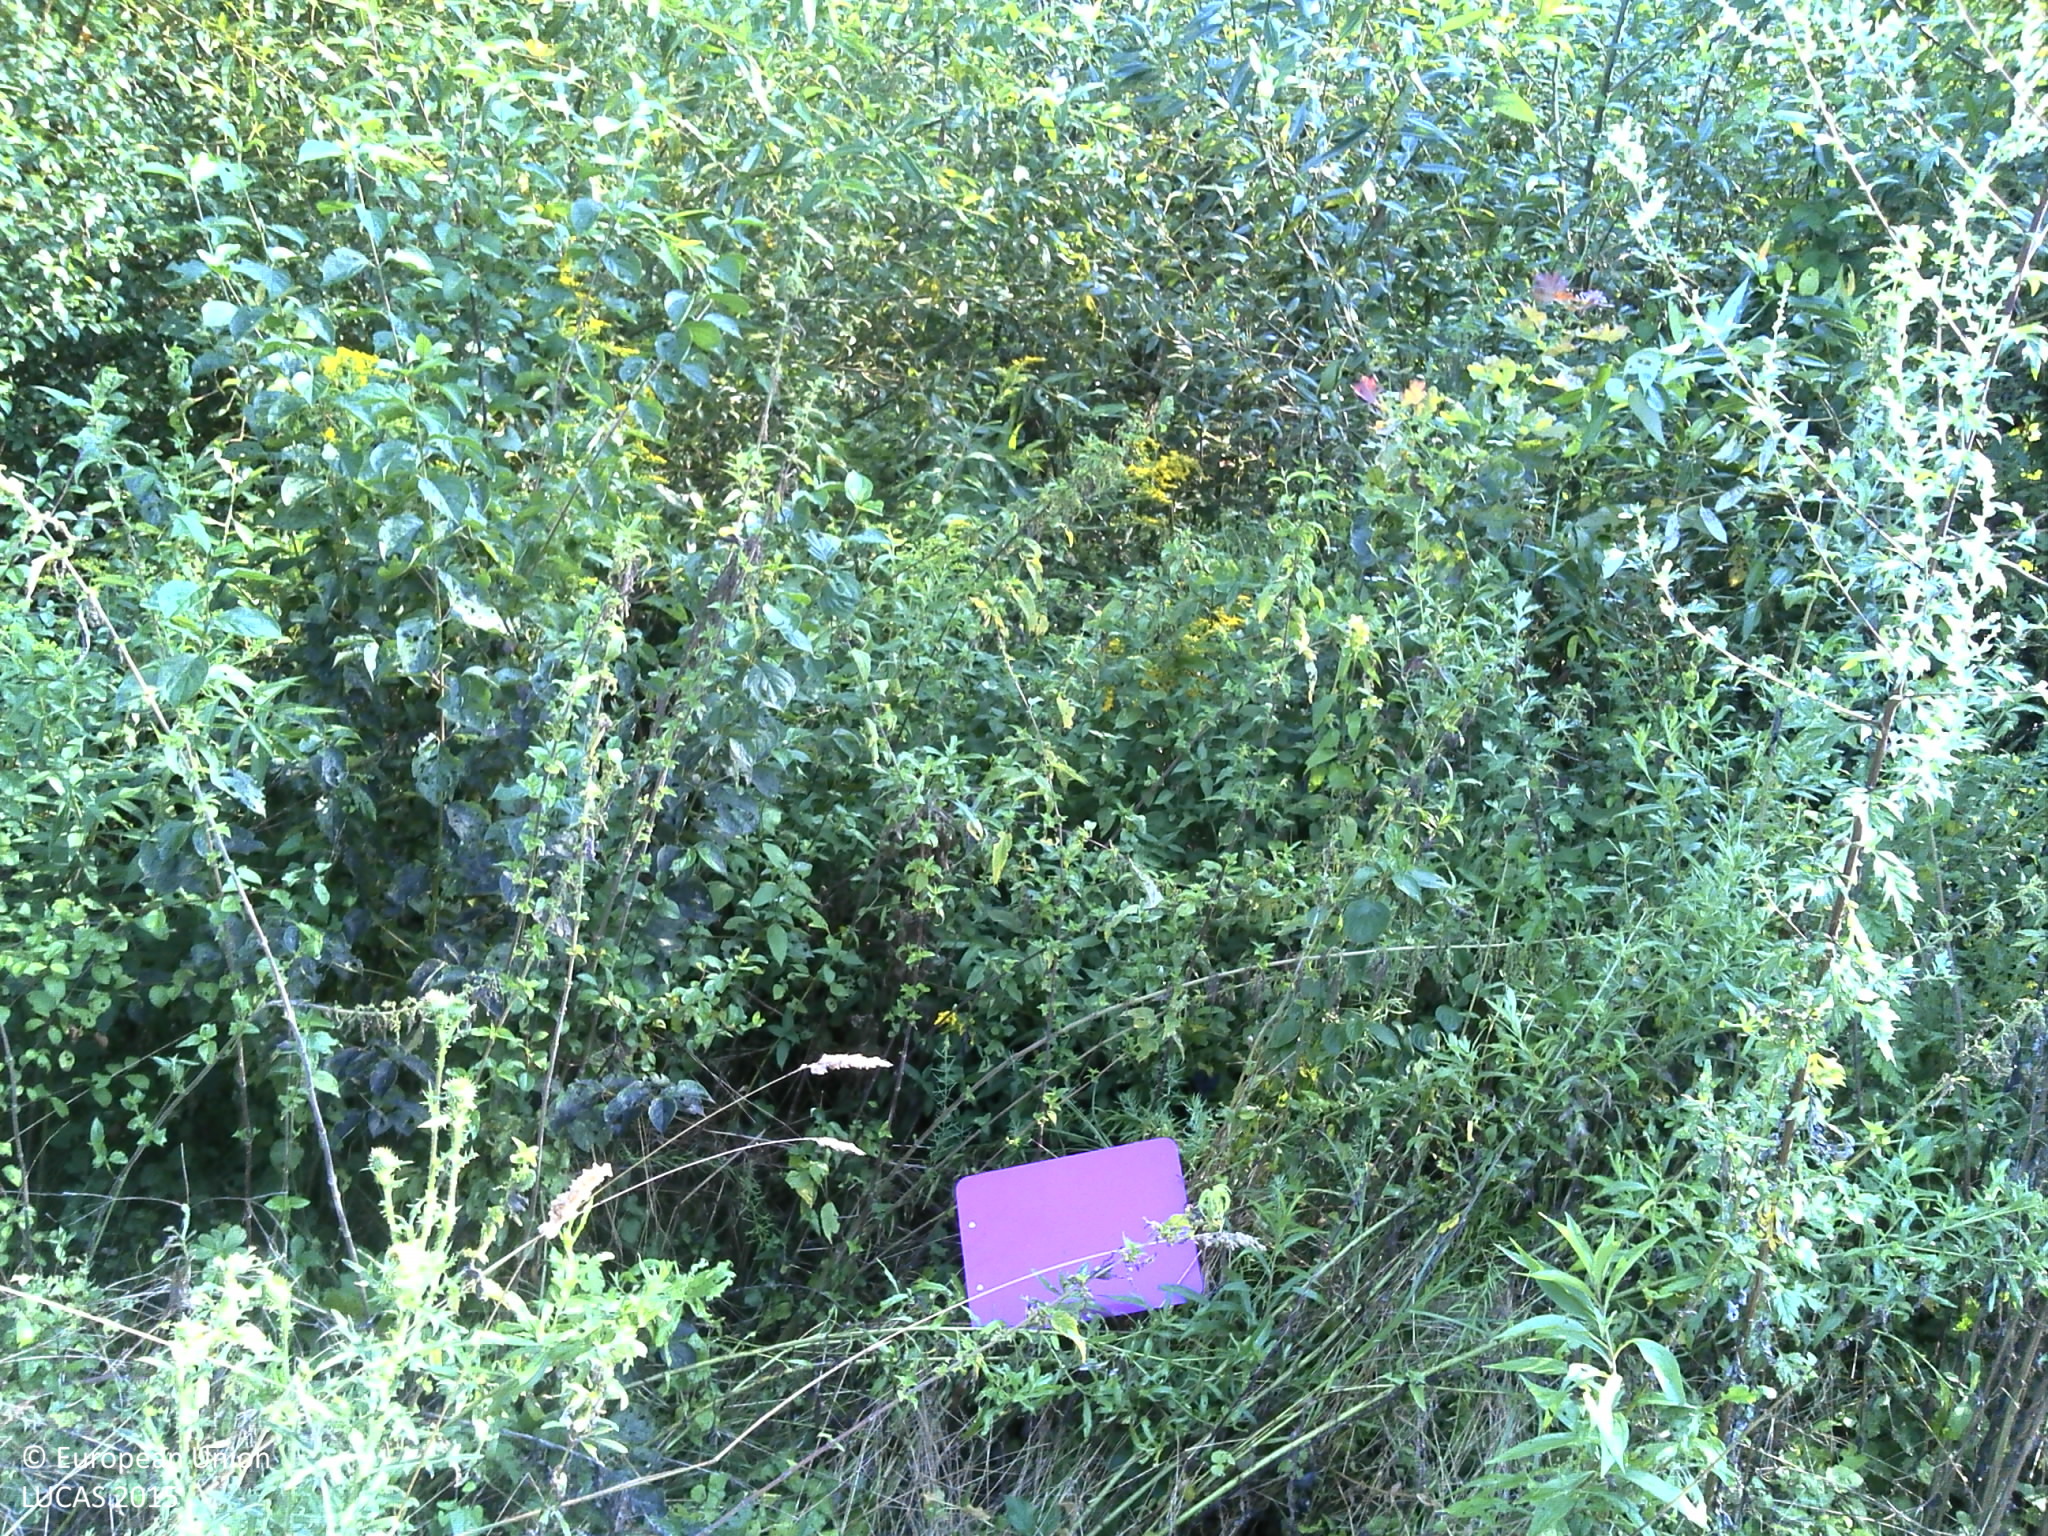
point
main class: Shrubland
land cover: Shrubland without tree cover
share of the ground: > 75 %
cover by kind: shrubs 100 %
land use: Forestry
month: August
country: HR
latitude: 45.6409
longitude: 16.8893
